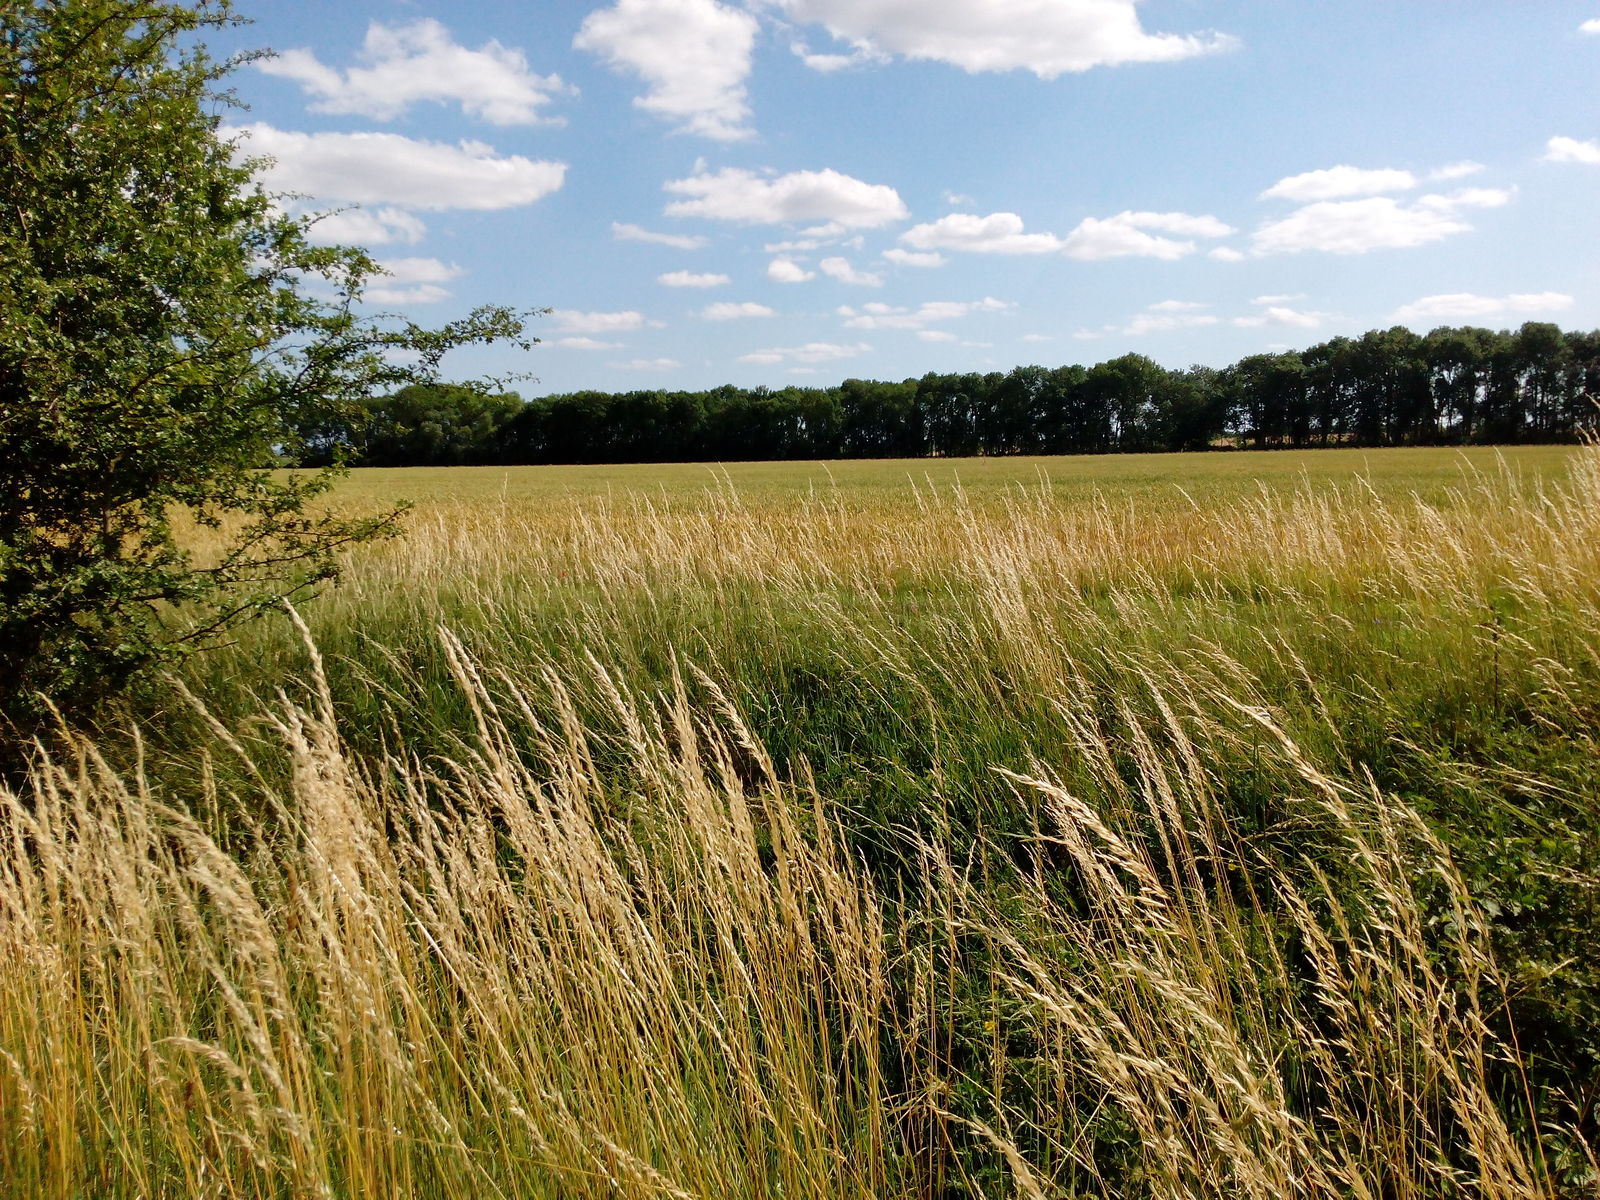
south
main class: Cropland
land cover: Common wheat
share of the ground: > 75 %
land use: Agriculture (excluding fallow land and kitchen gardens)
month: July
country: DE
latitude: 51.1140
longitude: 11.0996
